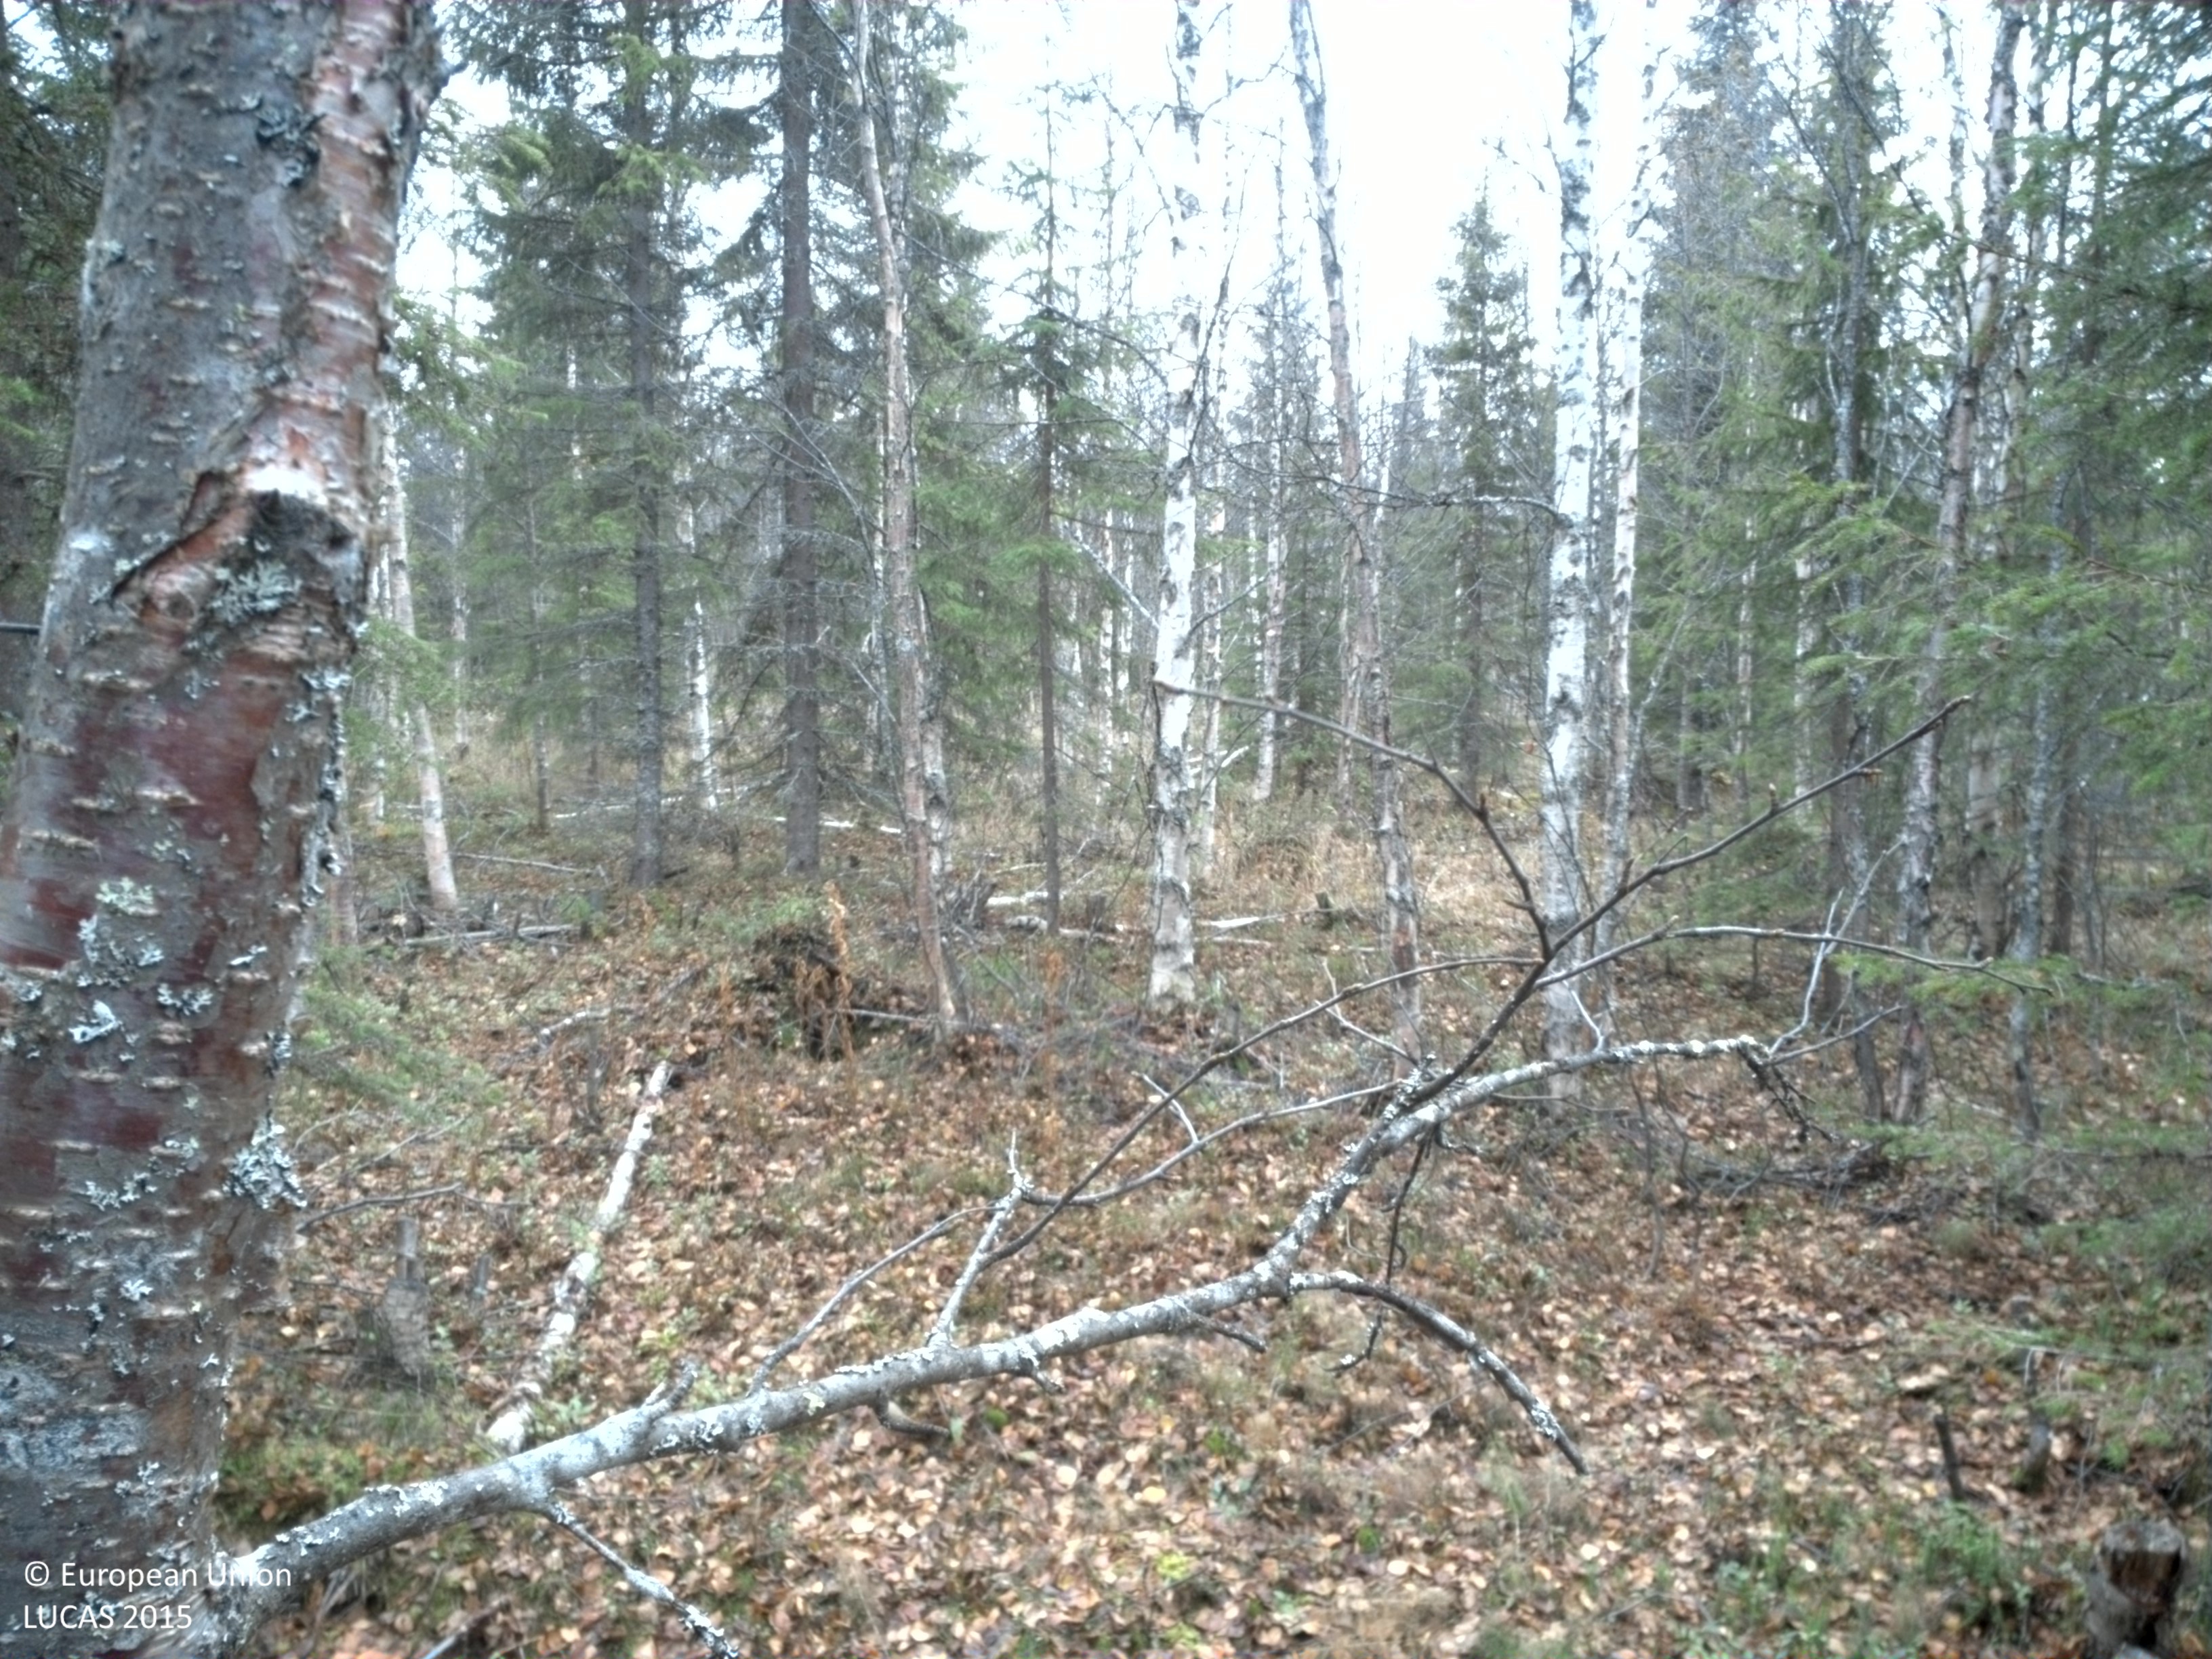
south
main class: Woodland
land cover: Spruce dominated mixed woodland
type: boreal forest
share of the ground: 50 - 75 %
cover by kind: broadleaved forest trees 35 %, unconsolidated bare surface 20 %, coniferous forest trees 15 %, herbaceous plants 15 %, shrubs 10 %, lichens and mosses 5 %
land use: Forestry
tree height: > 5 m
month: October
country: SE
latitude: 64.9902
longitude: 16.9385
